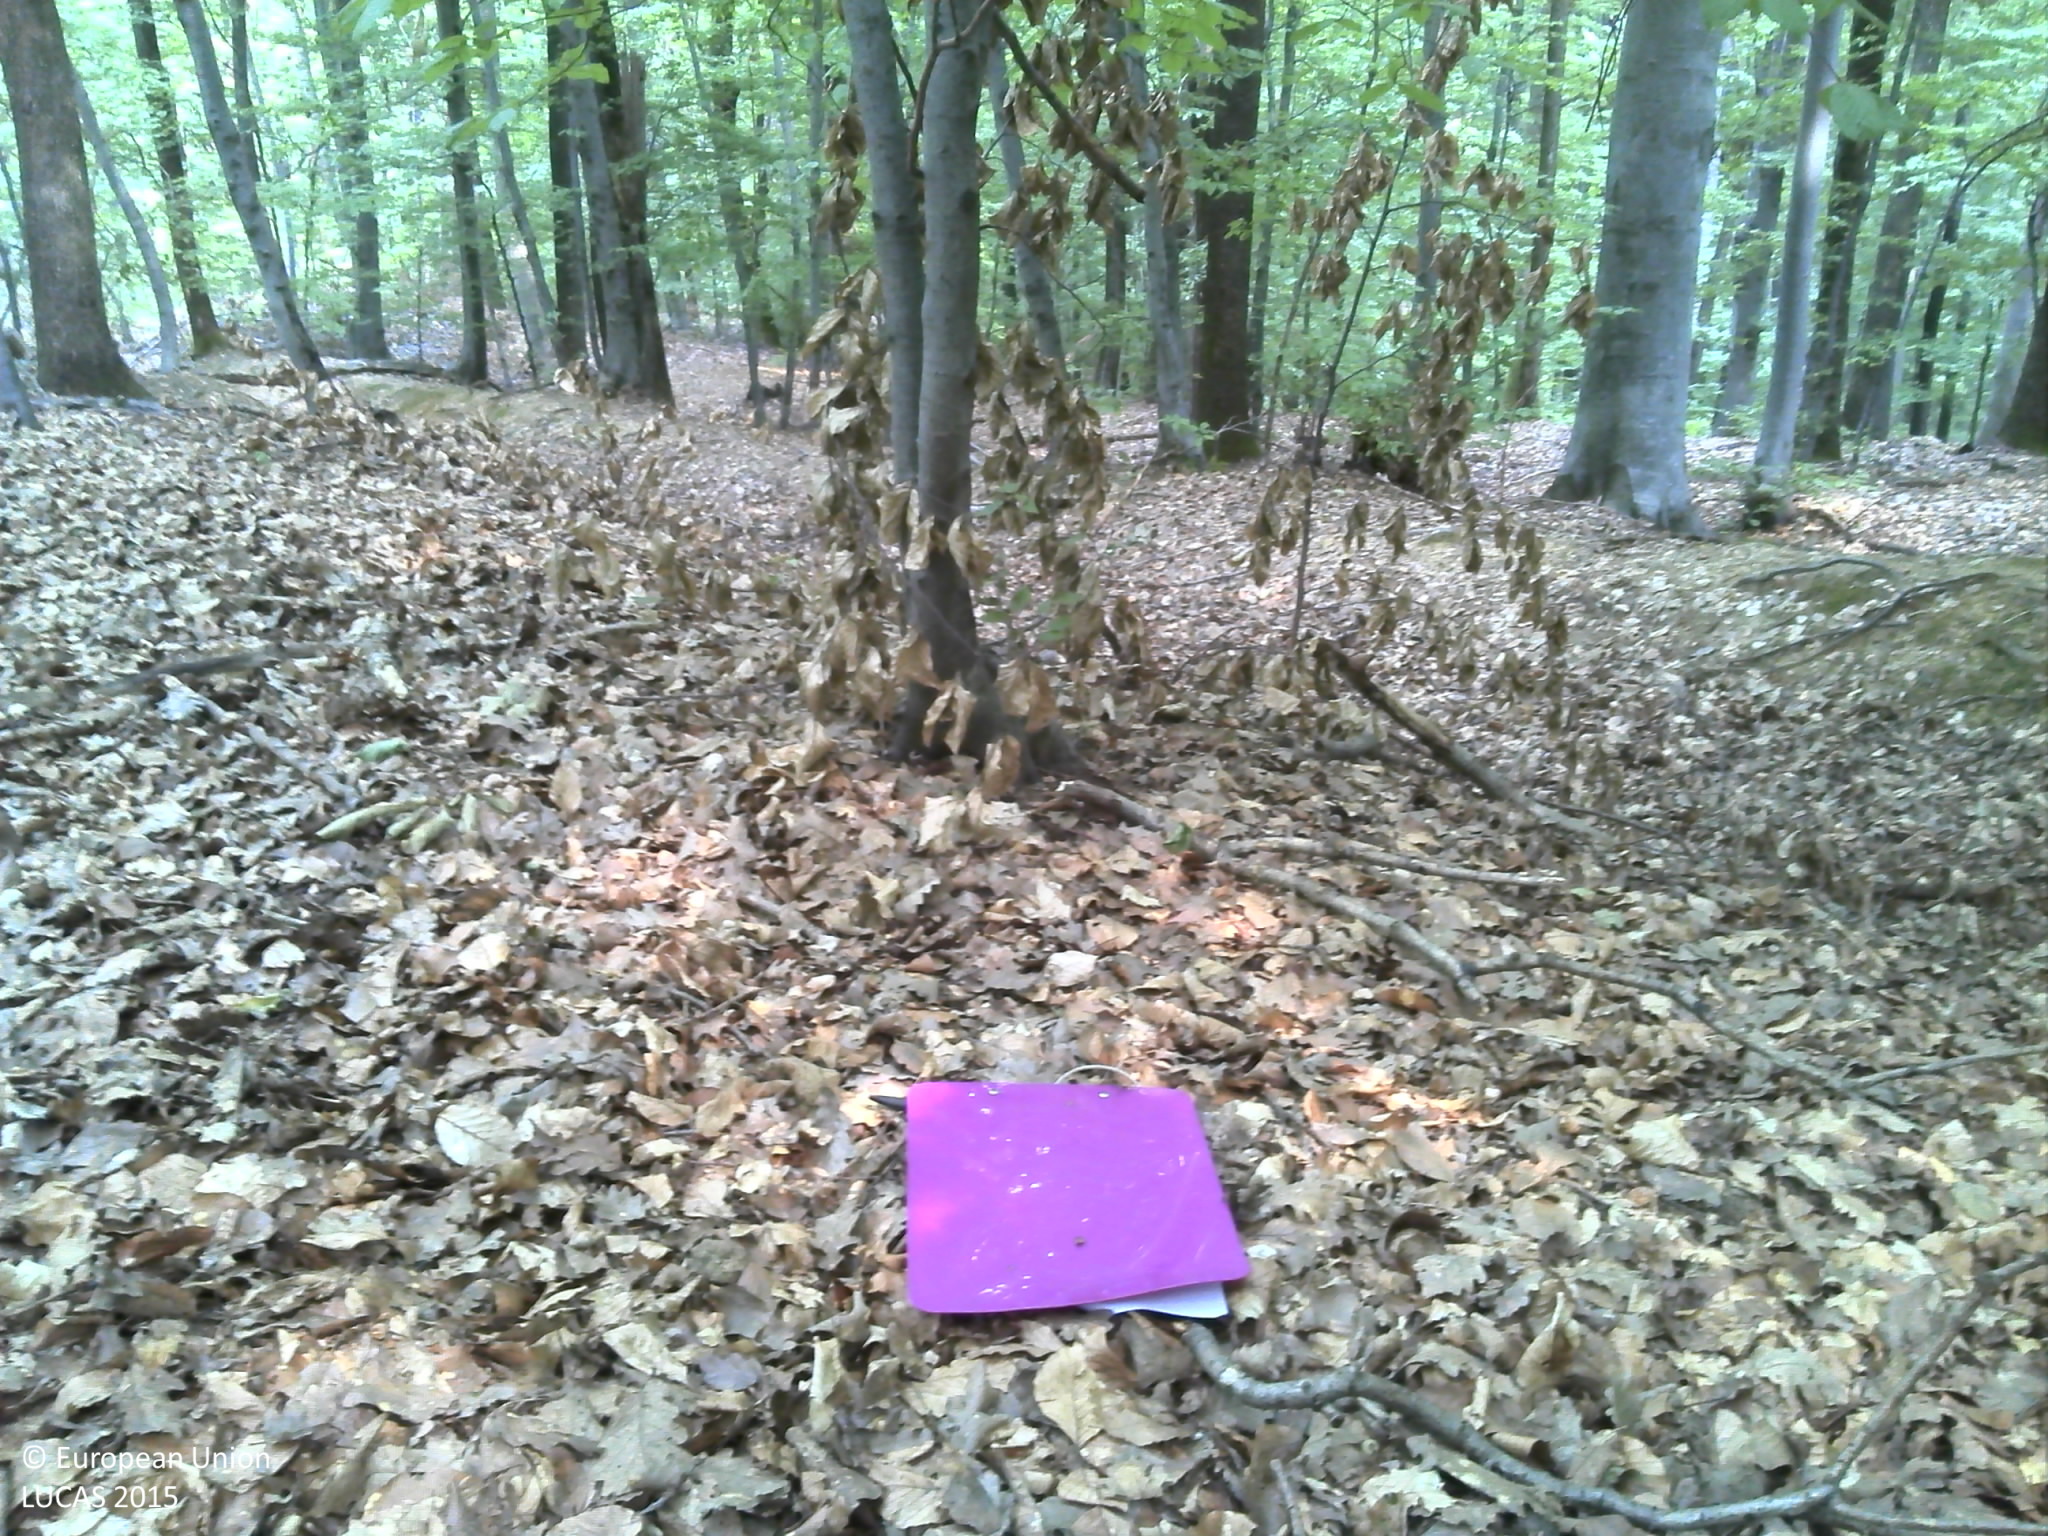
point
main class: Woodland
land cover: Broadleaved woodland
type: acidophilous oak and oak-birch forest
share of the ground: > 75 %
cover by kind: broadleaved forest trees 100 %
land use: Forestry
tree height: > 5 m
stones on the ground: < 10 %
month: August
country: HR
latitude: 45.4959
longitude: 17.9245
